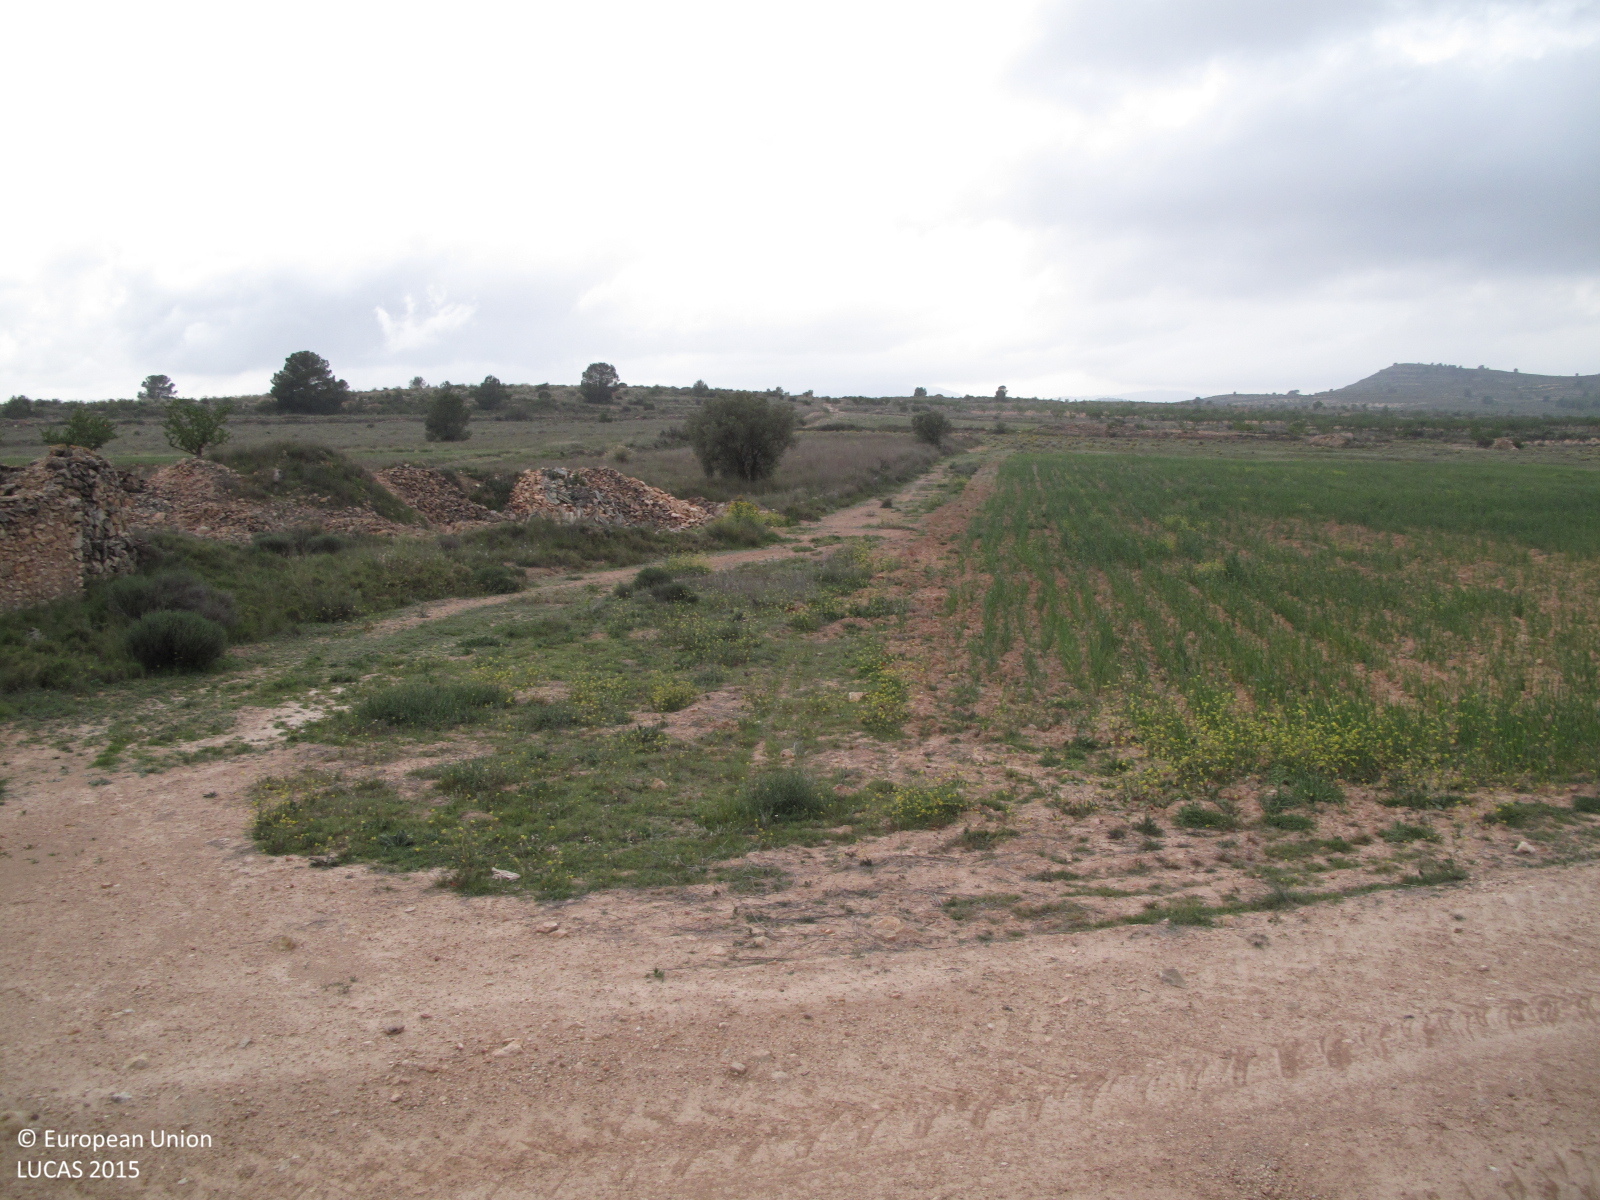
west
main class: Cropland
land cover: Nuts trees
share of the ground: < 10 %
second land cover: Other bare soil
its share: > 75 %
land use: Agriculture (excluding fallow land and kitchen gardens)
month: April
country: ES
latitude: 38.4266
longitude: -0.9735
